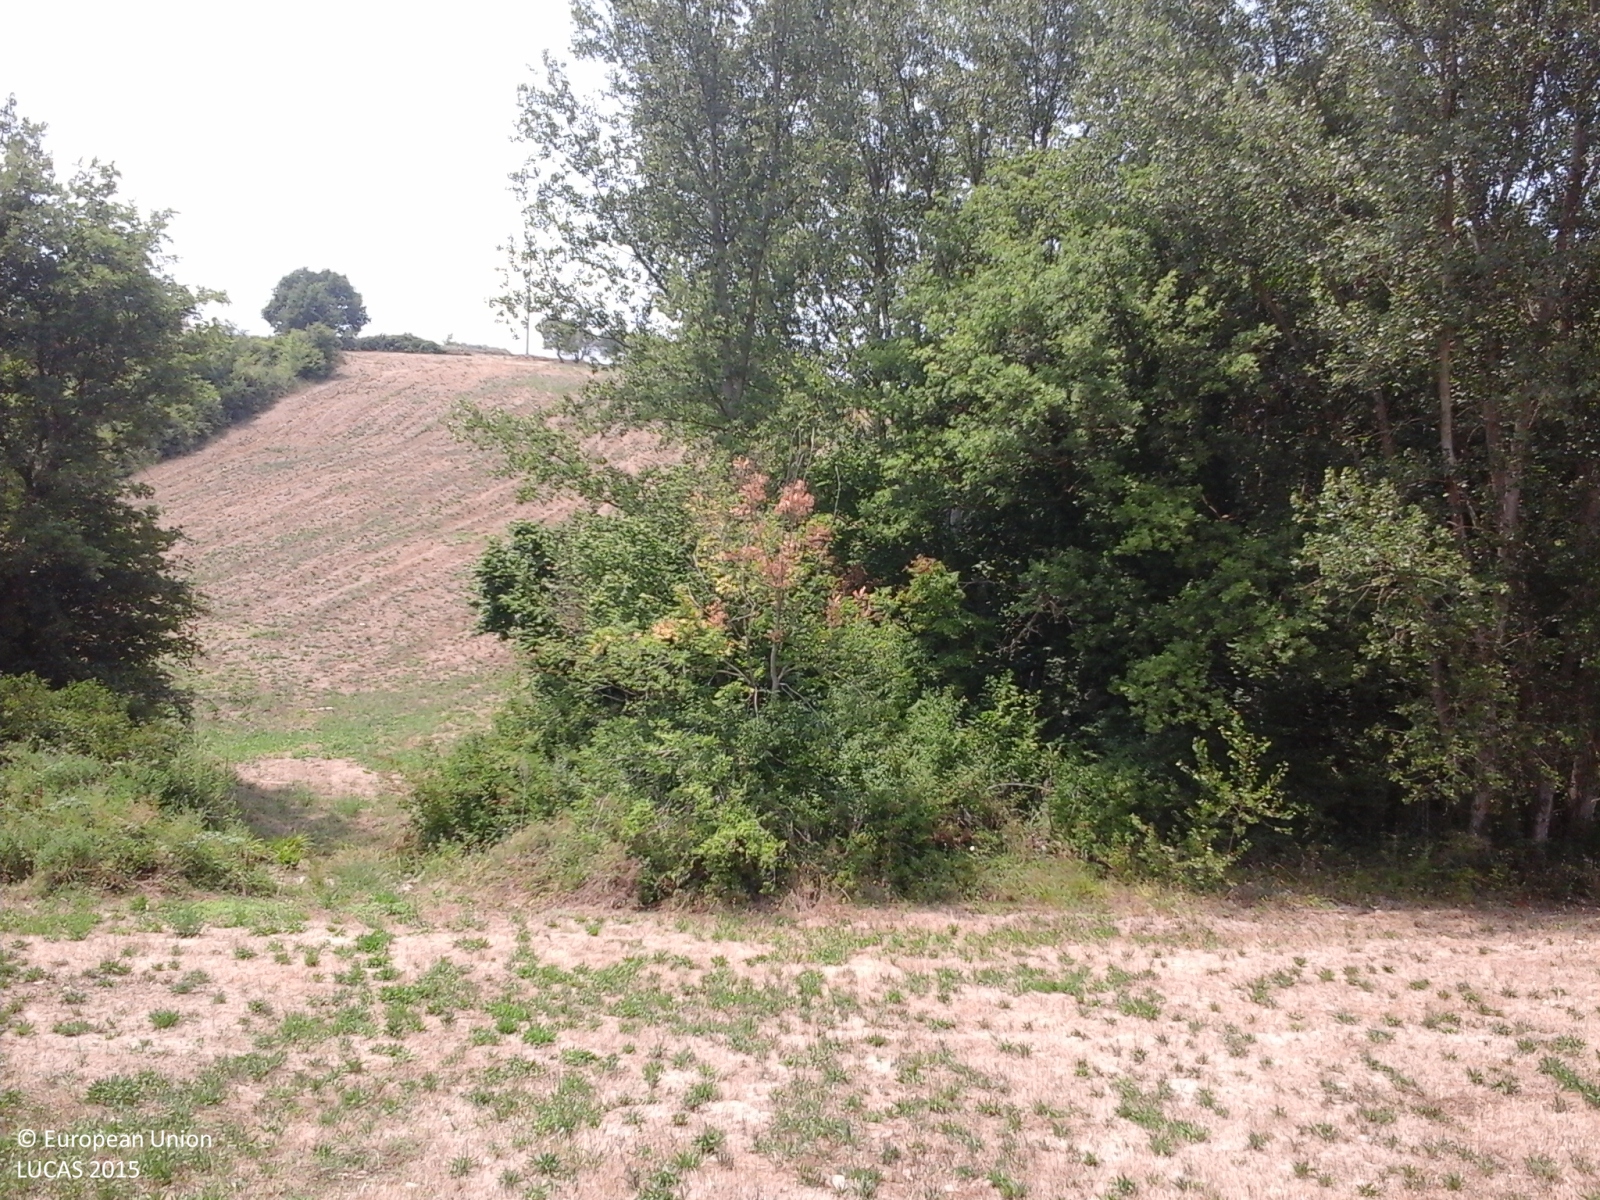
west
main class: Grassland
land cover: Spontaneously vegetated surfaces
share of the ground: > 75 %
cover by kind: herbaceous plants 90 %, consolidated bare surface 10 %
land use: Agriculture (excluding fallow land and kitchen gardens)
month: July
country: IT
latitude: 40.9515
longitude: 15.0769
